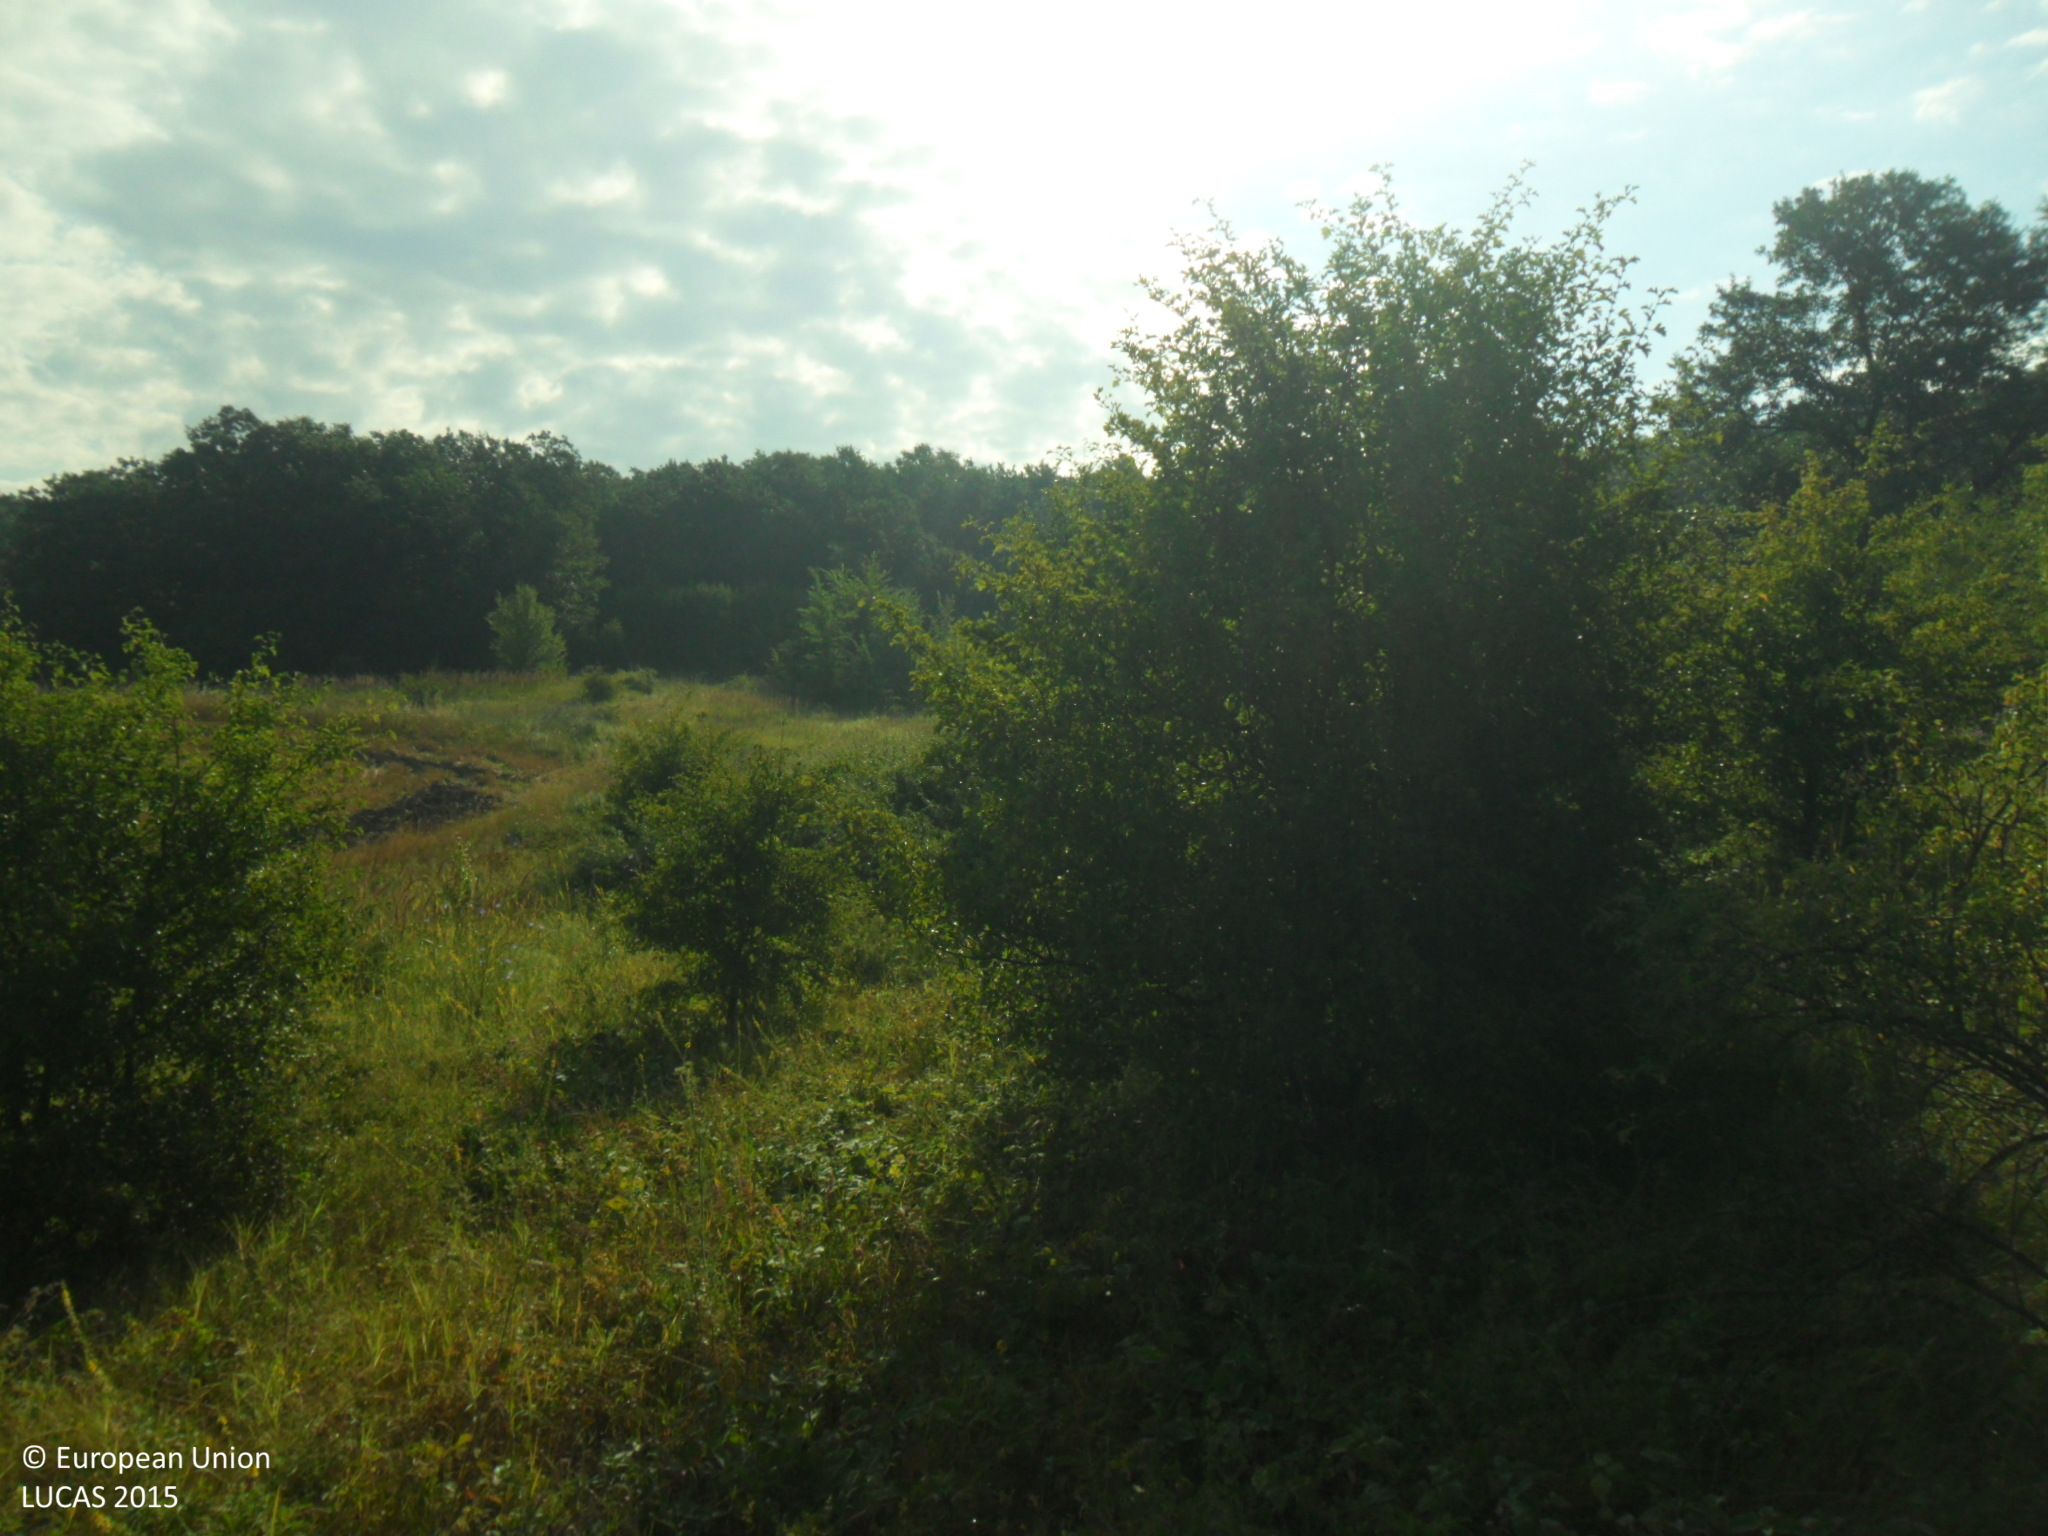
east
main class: Shrubland
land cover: Shrubland with sparse tree cover
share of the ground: > 75 %
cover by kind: shrubs 75 %, herbaceous plants 20 %, broadleaved forest trees 5 %
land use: Forestry
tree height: < 5 m
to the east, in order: Shrubland with sparse tree cover; Electric lines; Shrubland with sparse tree cover; Broadleaved woodland
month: July
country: BG
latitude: 43.1698
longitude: 27.0275
